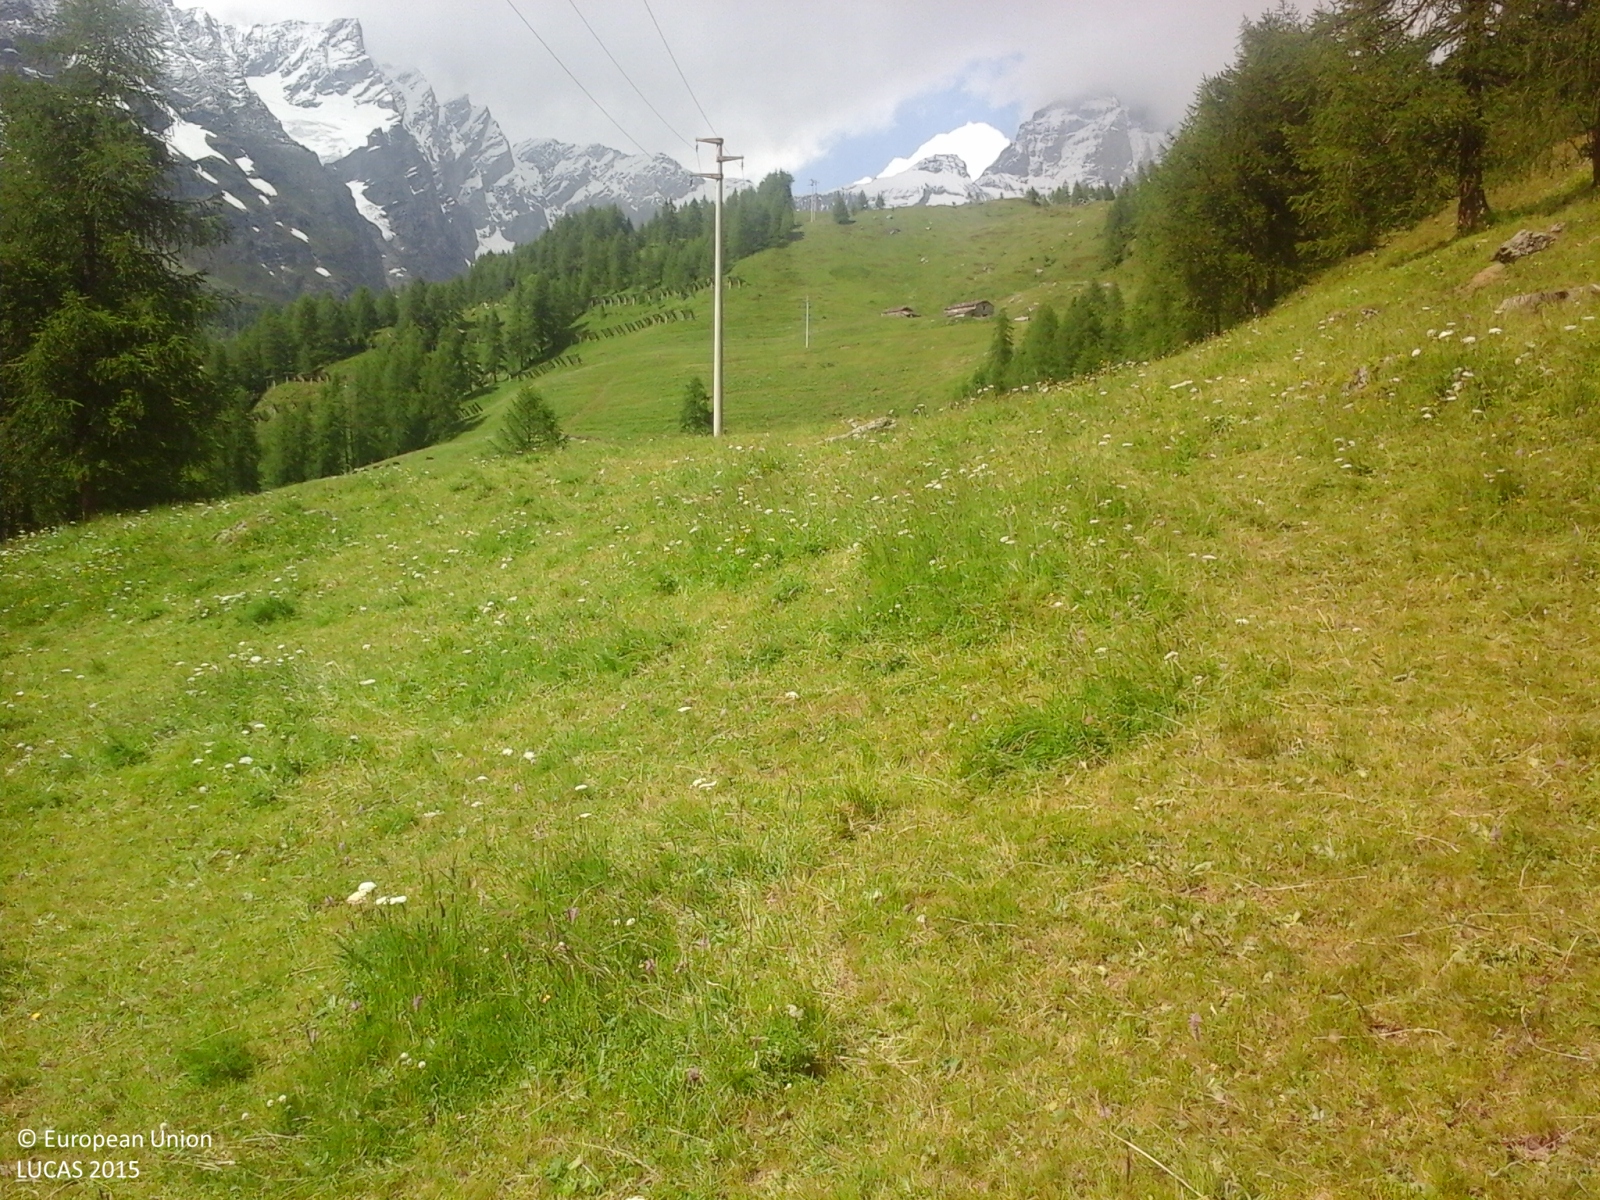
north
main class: Grassland
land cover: Grassland without tree/shrub cover
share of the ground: > 75 %
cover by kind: herbaceous plants 100 %
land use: Agriculture (excluding fallow land and kitchen gardens)
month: June
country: IT
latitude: 45.9102
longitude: 7.6183
